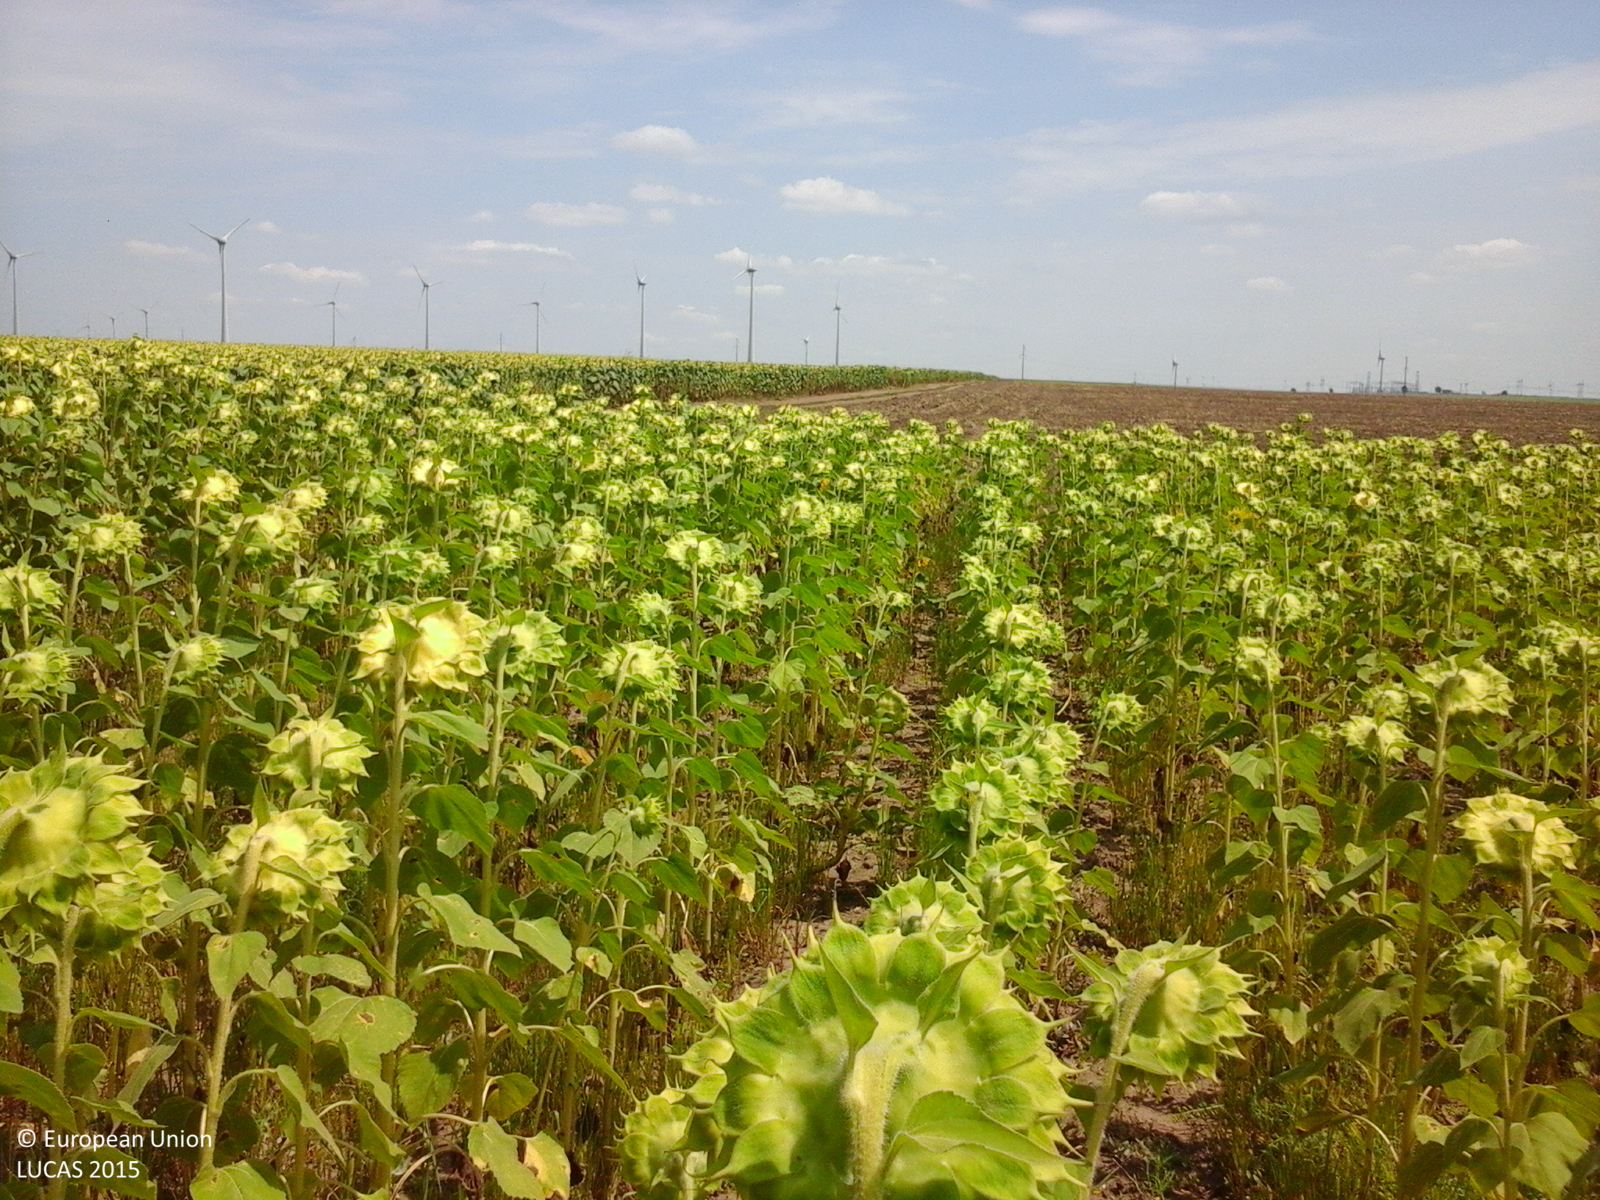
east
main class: Cropland
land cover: Sunflower
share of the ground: > 75 %
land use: Agriculture (excluding fallow land and kitchen gardens)
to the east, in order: Sunflower; Grass margins; Tracks; Grass margins; Common wheat; Sunflower
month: August
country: RO
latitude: 44.8076
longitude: 28.2105
